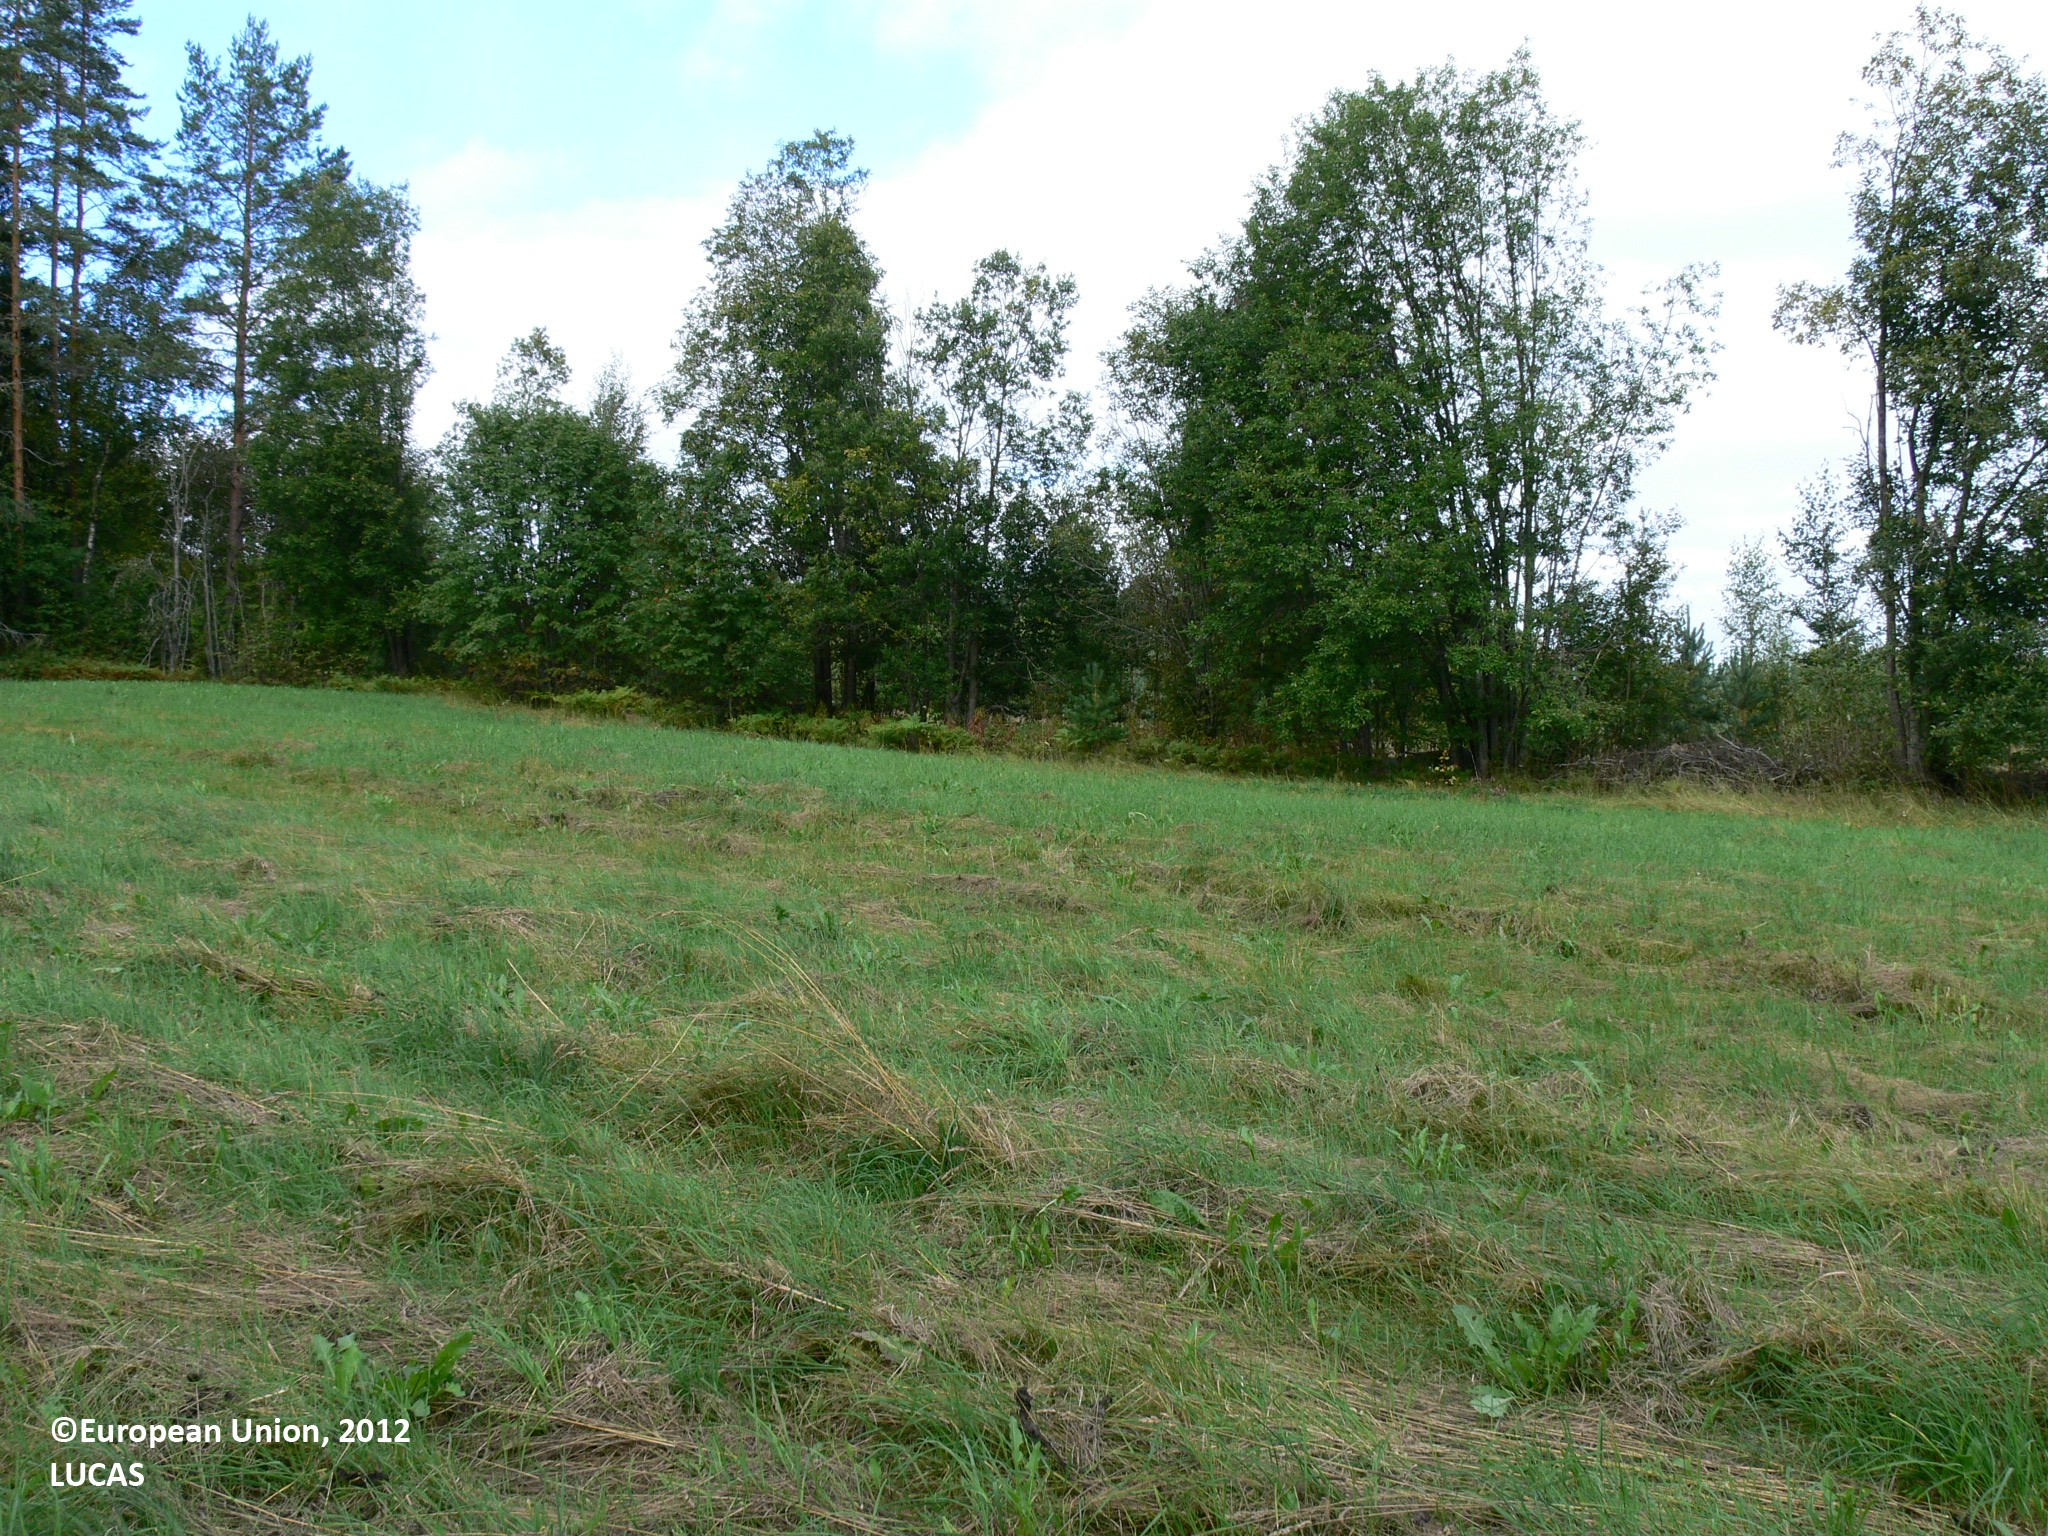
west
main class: Cropland
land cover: Temporary grasslands
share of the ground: 50 - 75 %
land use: Agriculture (excluding fallow land and kitchen gardens)
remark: Harvested field
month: August
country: FI
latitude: 62.0348
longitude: 30.2527
